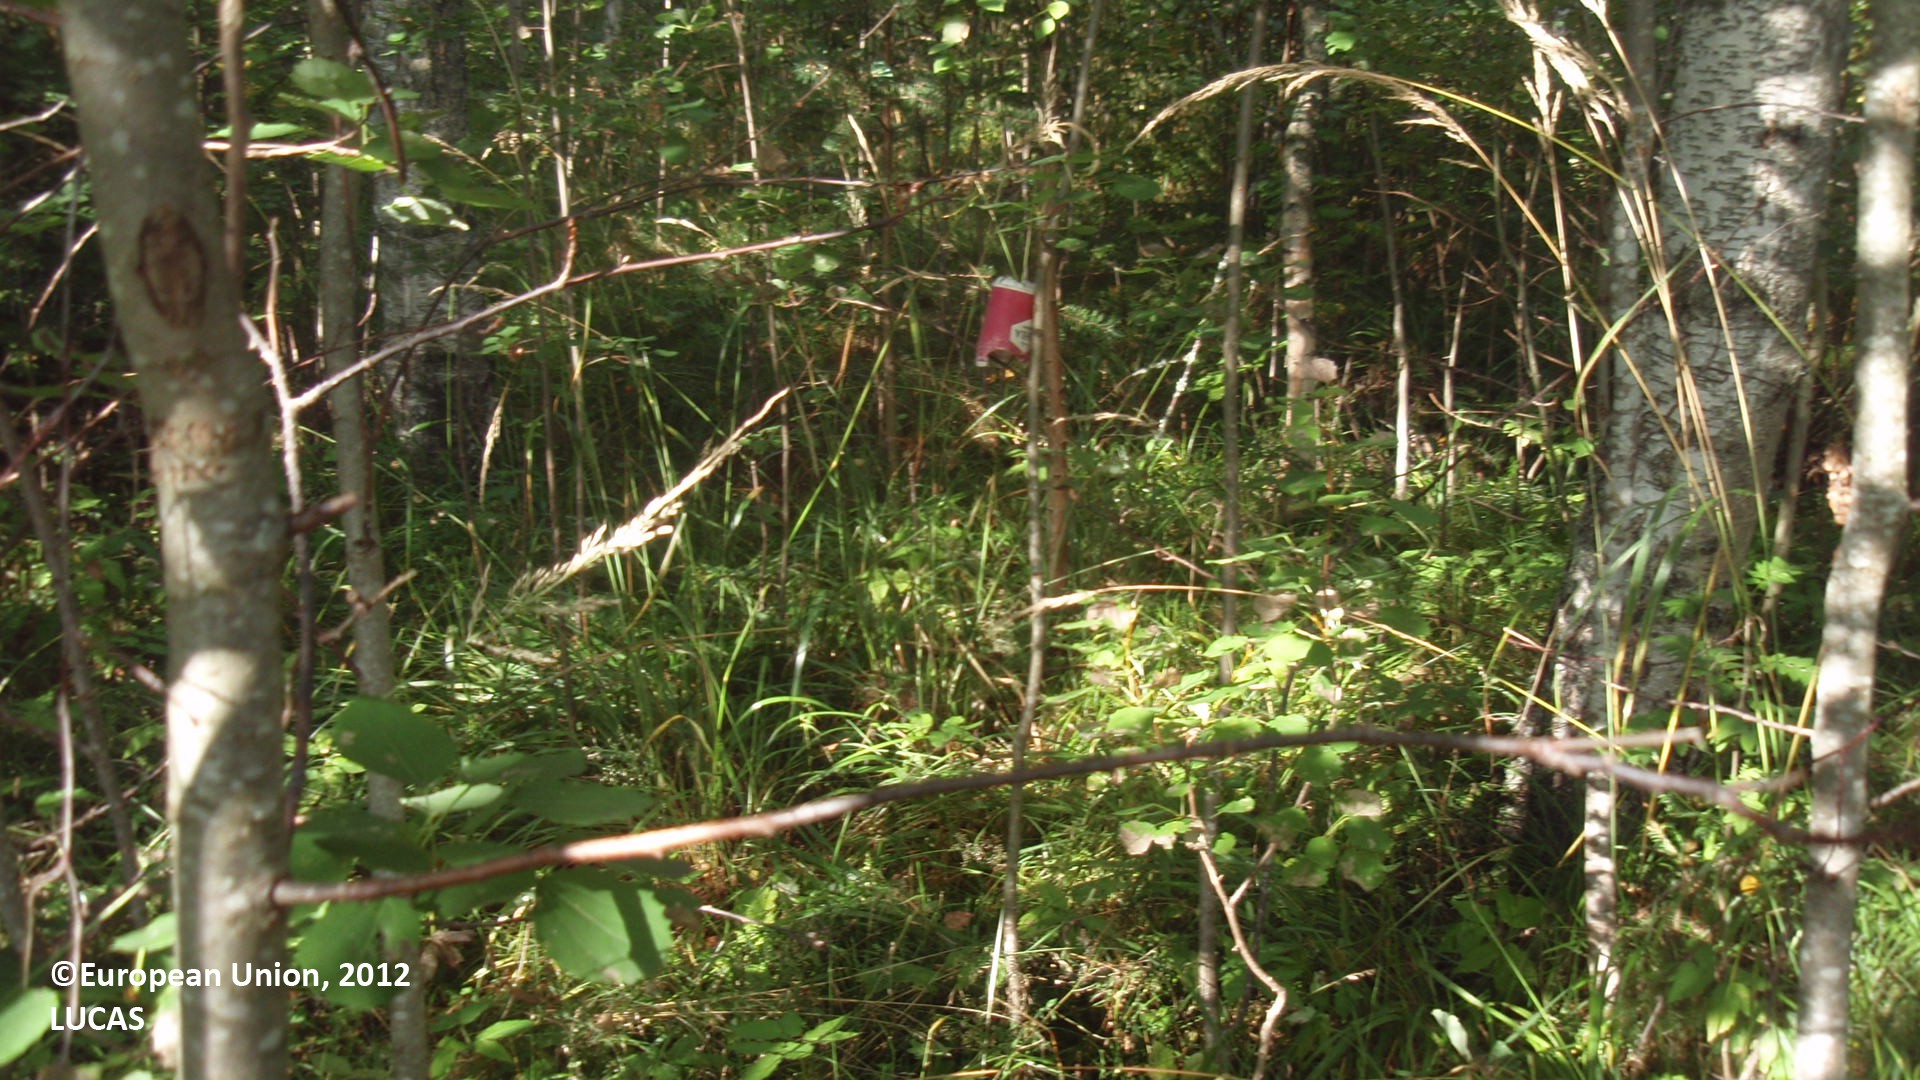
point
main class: Woodland
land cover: Broadleaved woodland
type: non-riverine alder, birch or aspen forest
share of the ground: 50 - 75 %
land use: Forestry
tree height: > 5 m
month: August
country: FI
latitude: 60.6162
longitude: 27.1481
